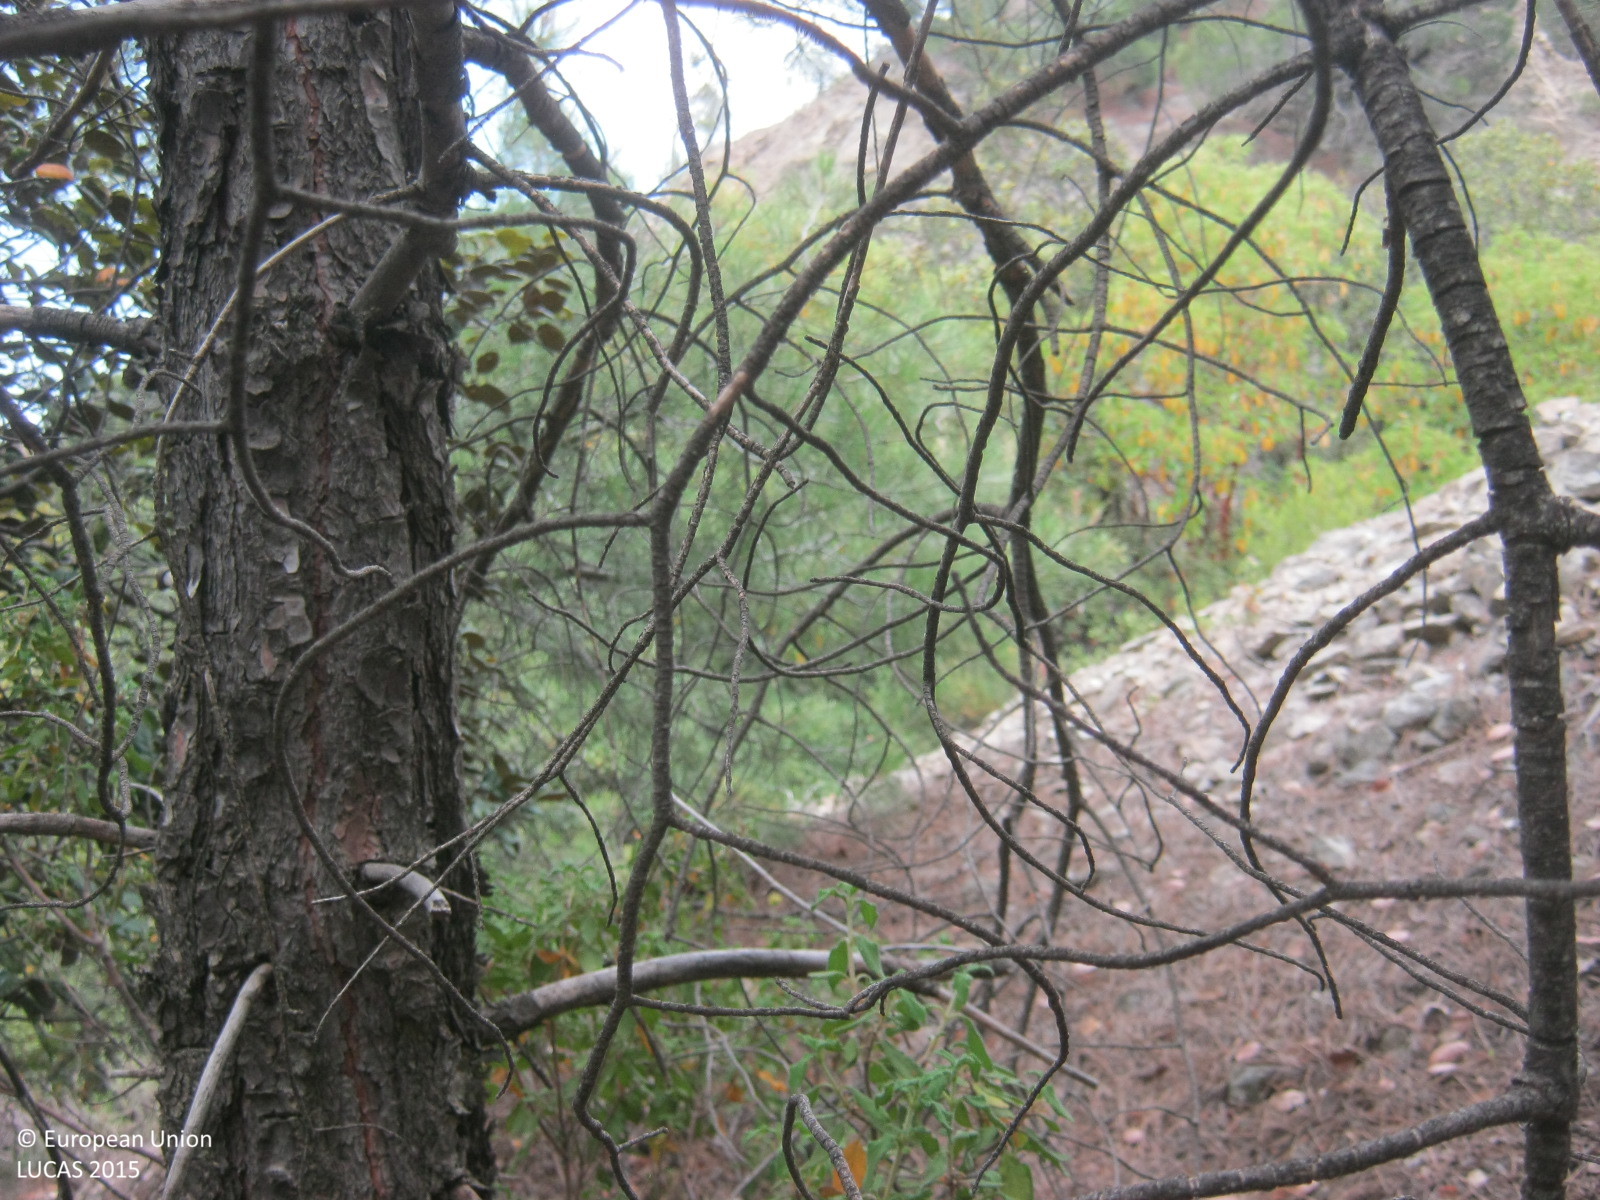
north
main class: Woodland
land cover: Pine dominated mixed woodland
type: coniferous forest of the mediterranean region
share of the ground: > 75 %
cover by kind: coniferous forest trees 45 %, broadleaved forest trees 30 %, unconsolidated bare surface 15 %, shrubs 10 %
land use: Forestry
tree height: > 5 m
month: June
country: CY
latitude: 34.9812
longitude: 32.8538
